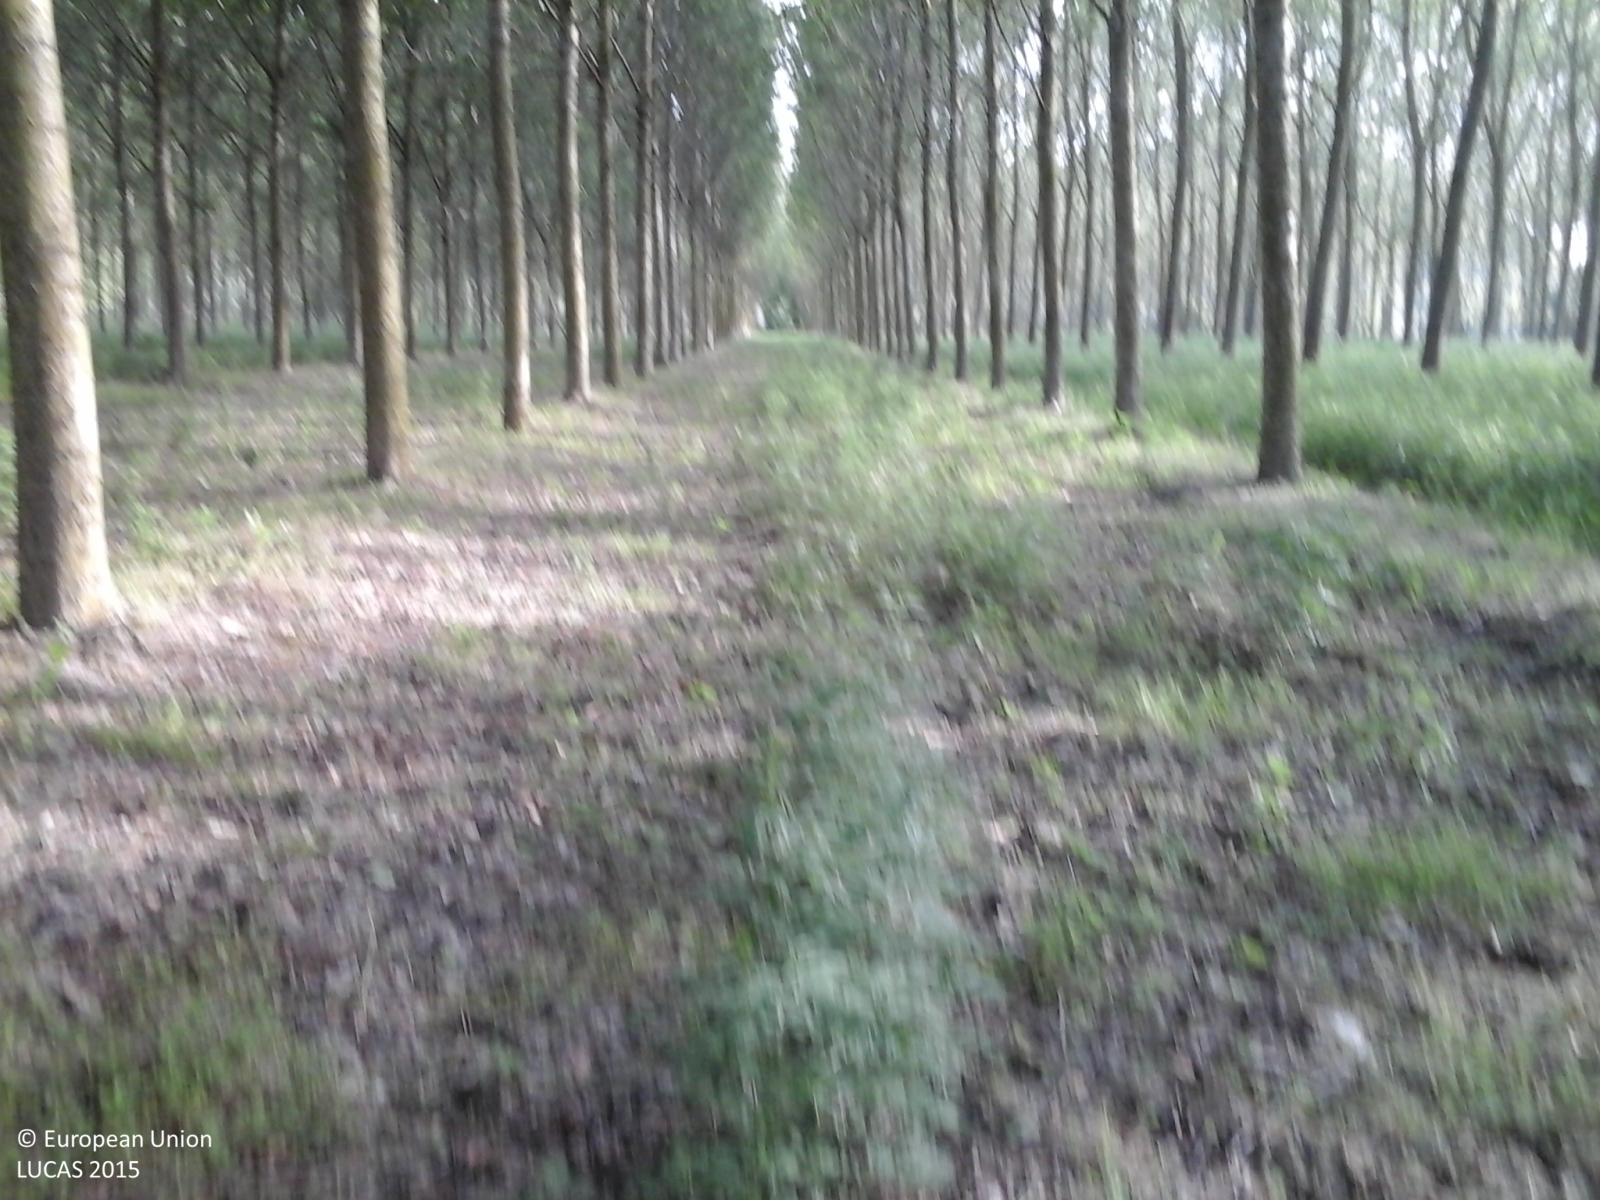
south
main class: Woodland
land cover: Broadleaved woodland
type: non-riverine alder, birch or aspen forest
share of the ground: > 75 %
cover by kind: broadleaved forest trees 80 %, herbaceous plants 20 %
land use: Forestry
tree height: > 5 m
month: May
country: IT
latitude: 45.1810
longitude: 8.1072
